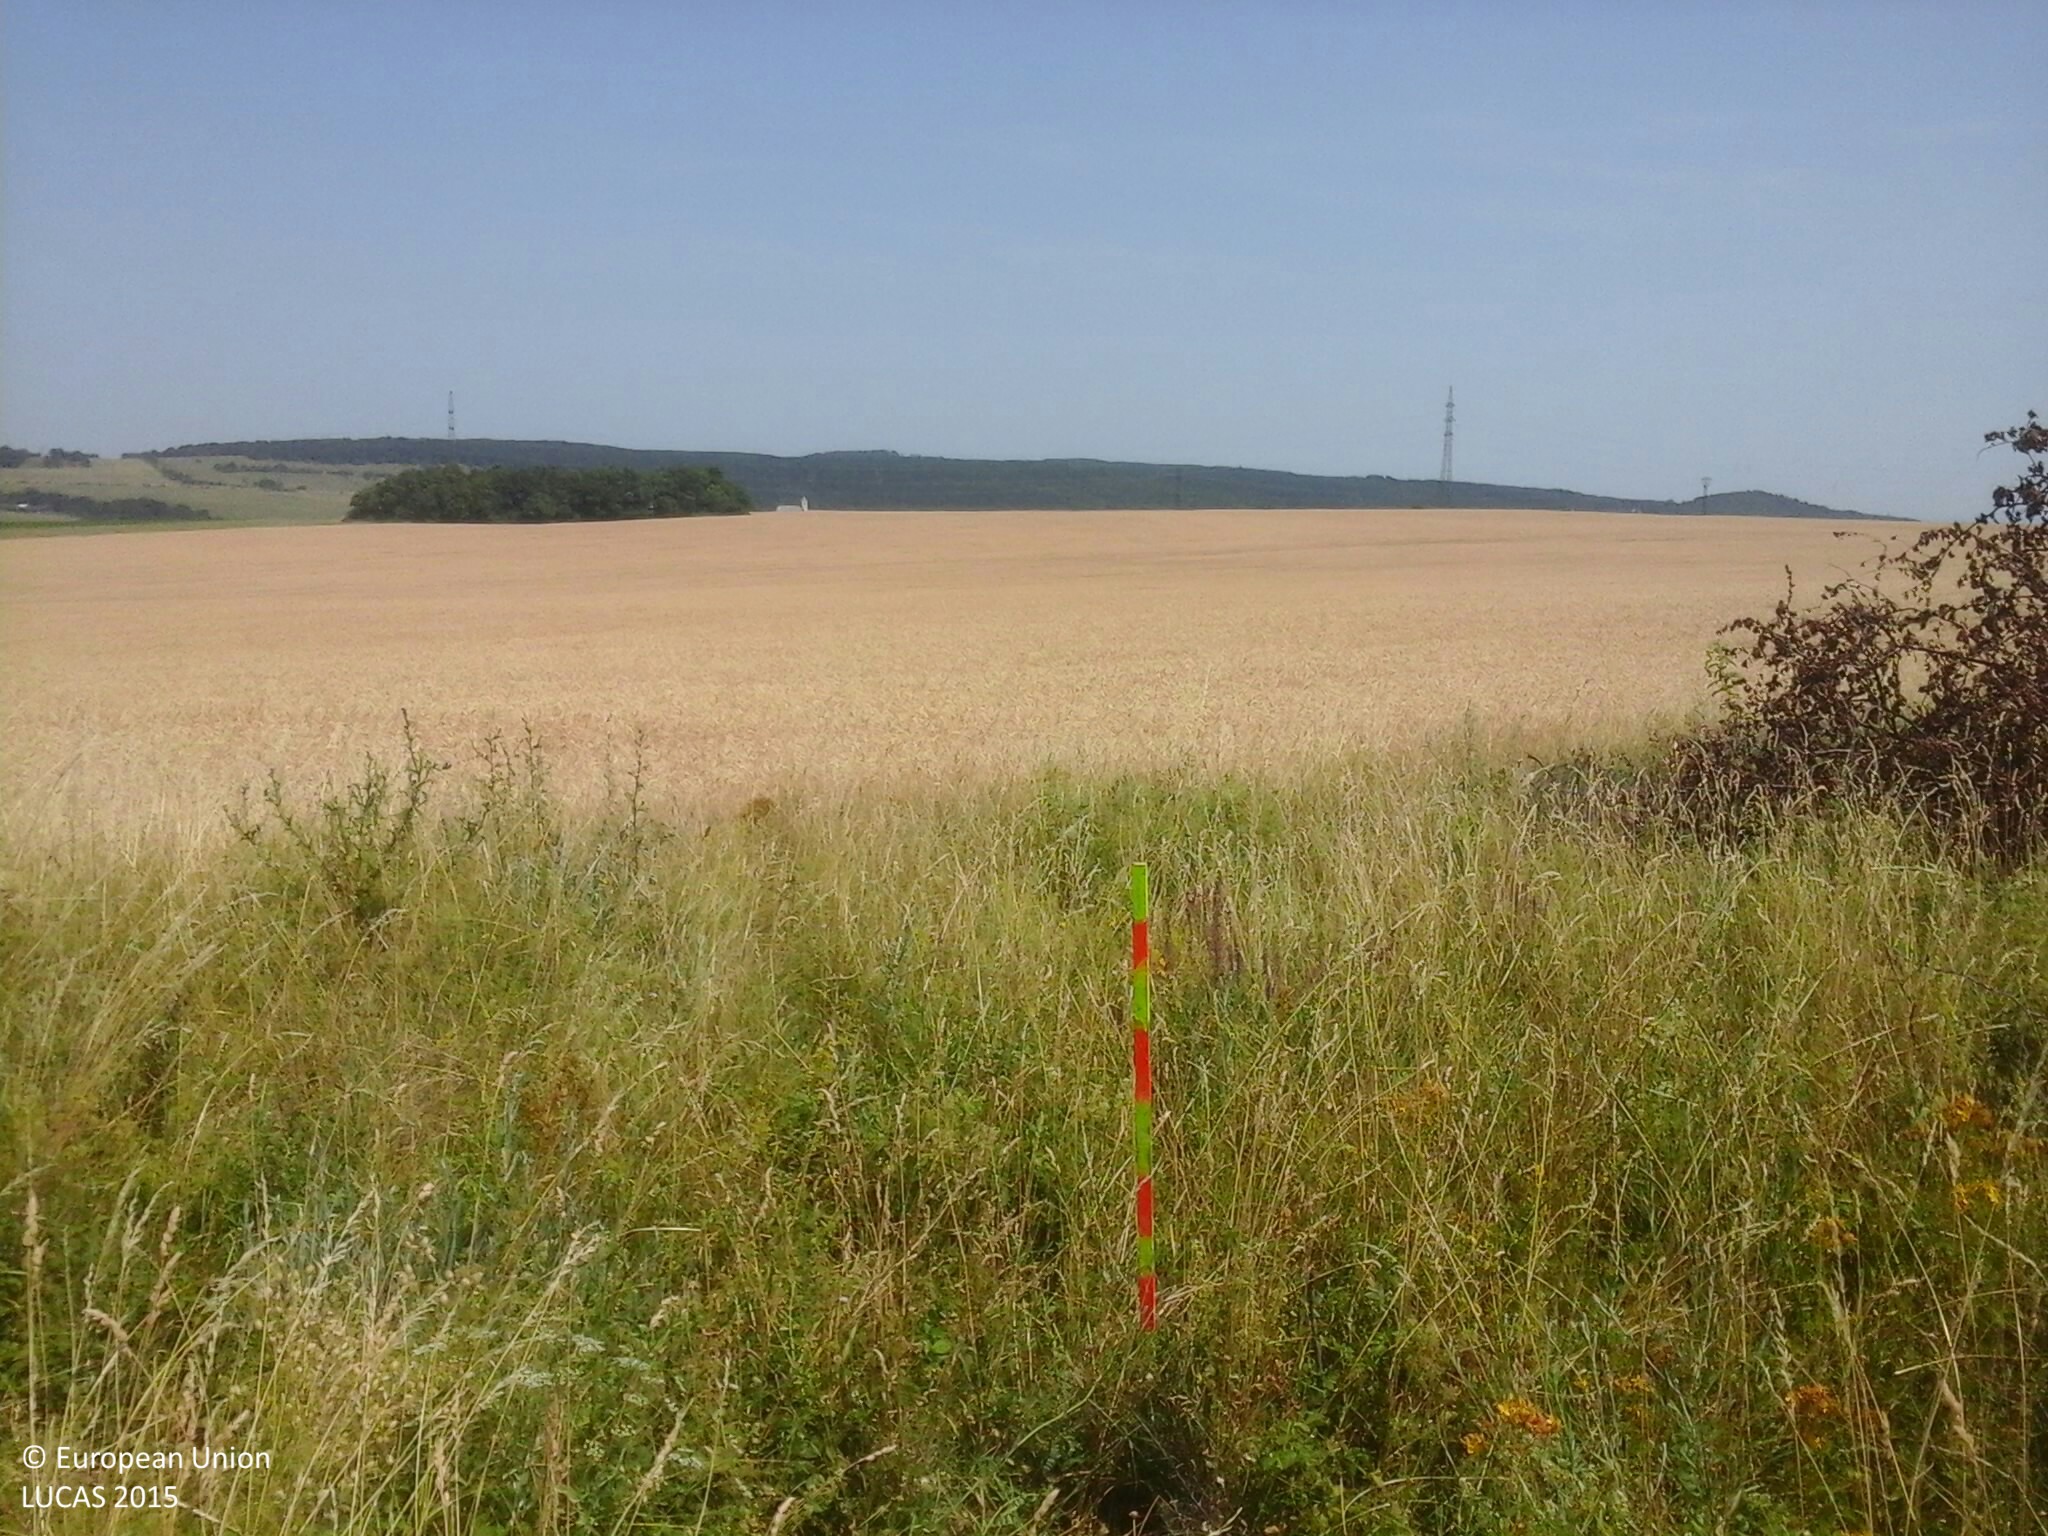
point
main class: Grassland
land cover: Grassland with sparse tree/shrub cover
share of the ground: > 75 %
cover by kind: herbaceous plants 90 %, broadleaved forest trees 5 %, shrubs 5 %
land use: Agriculture (excluding fallow land and kitchen gardens)
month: July
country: HU
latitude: 47.0062
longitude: 17.8076
